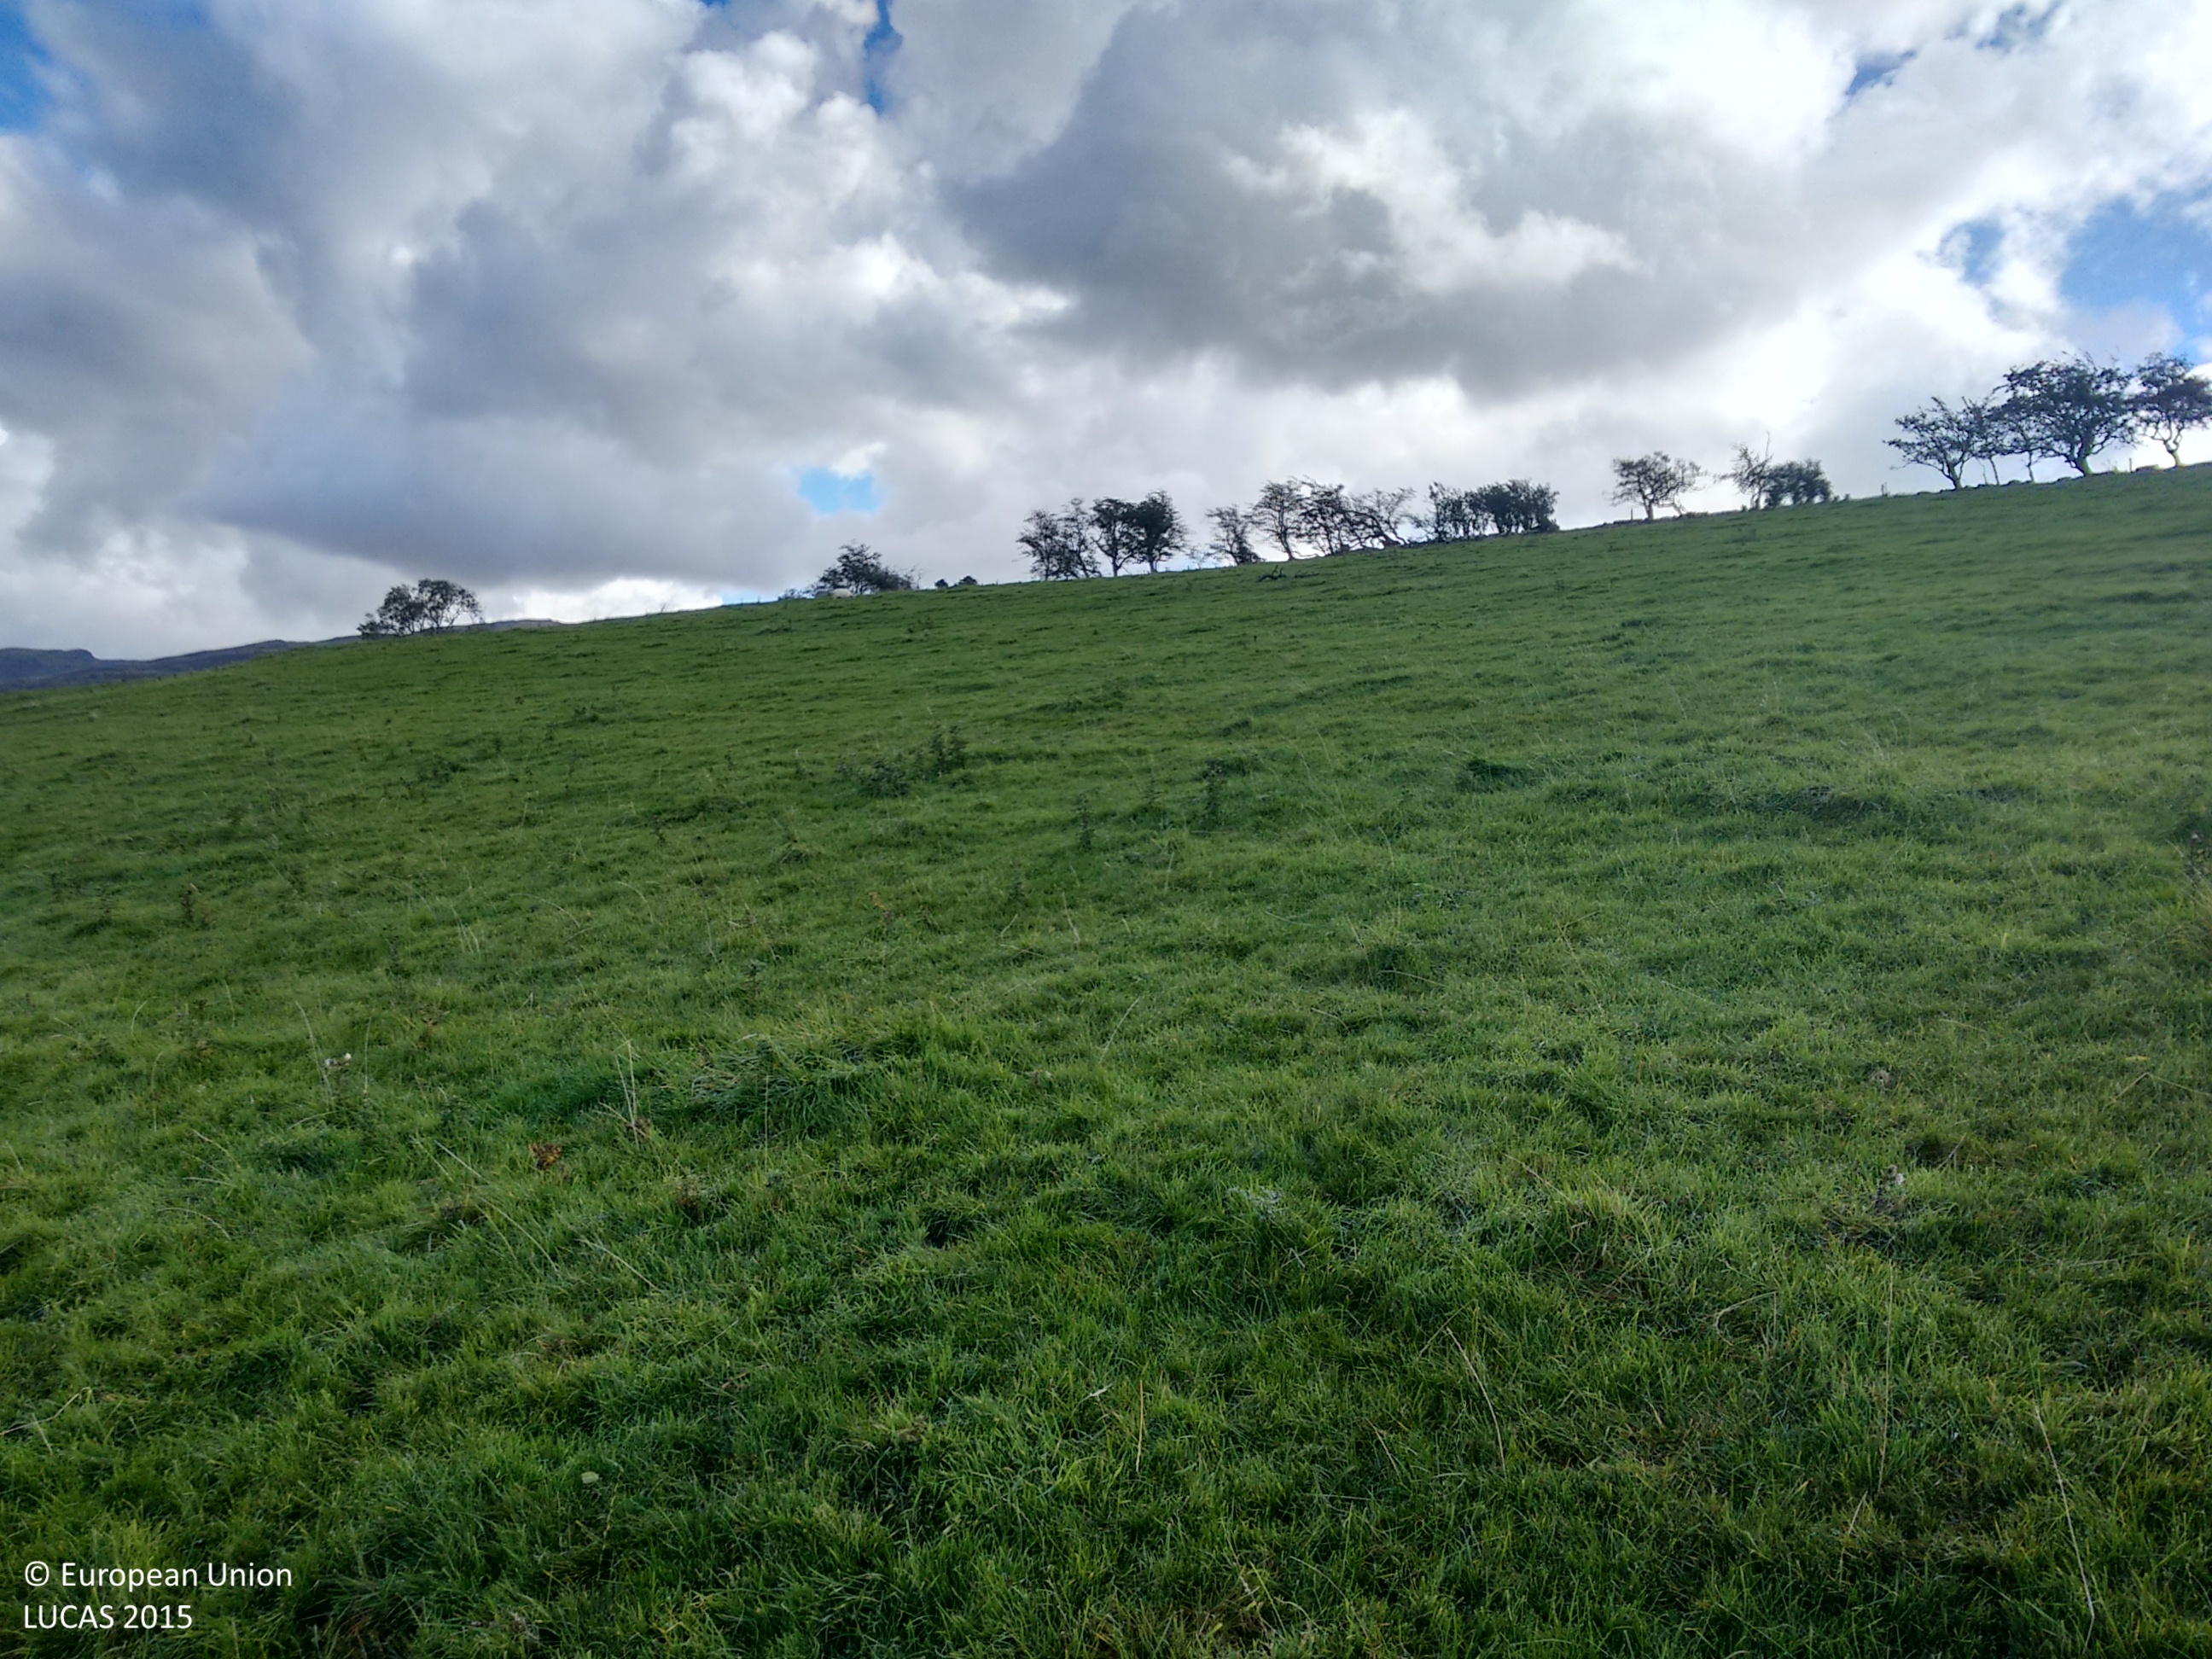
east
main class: Grassland
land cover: Grassland without tree/shrub cover
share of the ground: > 75 %
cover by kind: herbaceous plants 100 %
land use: Agriculture (excluding fallow land and kitchen gardens)
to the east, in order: Grassland without tree/shrub cover; Dry stone walls; Fences; Managed hedges; Grassland without tree/shrub cover
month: October
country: GB
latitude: 52.8842
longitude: -4.0800
